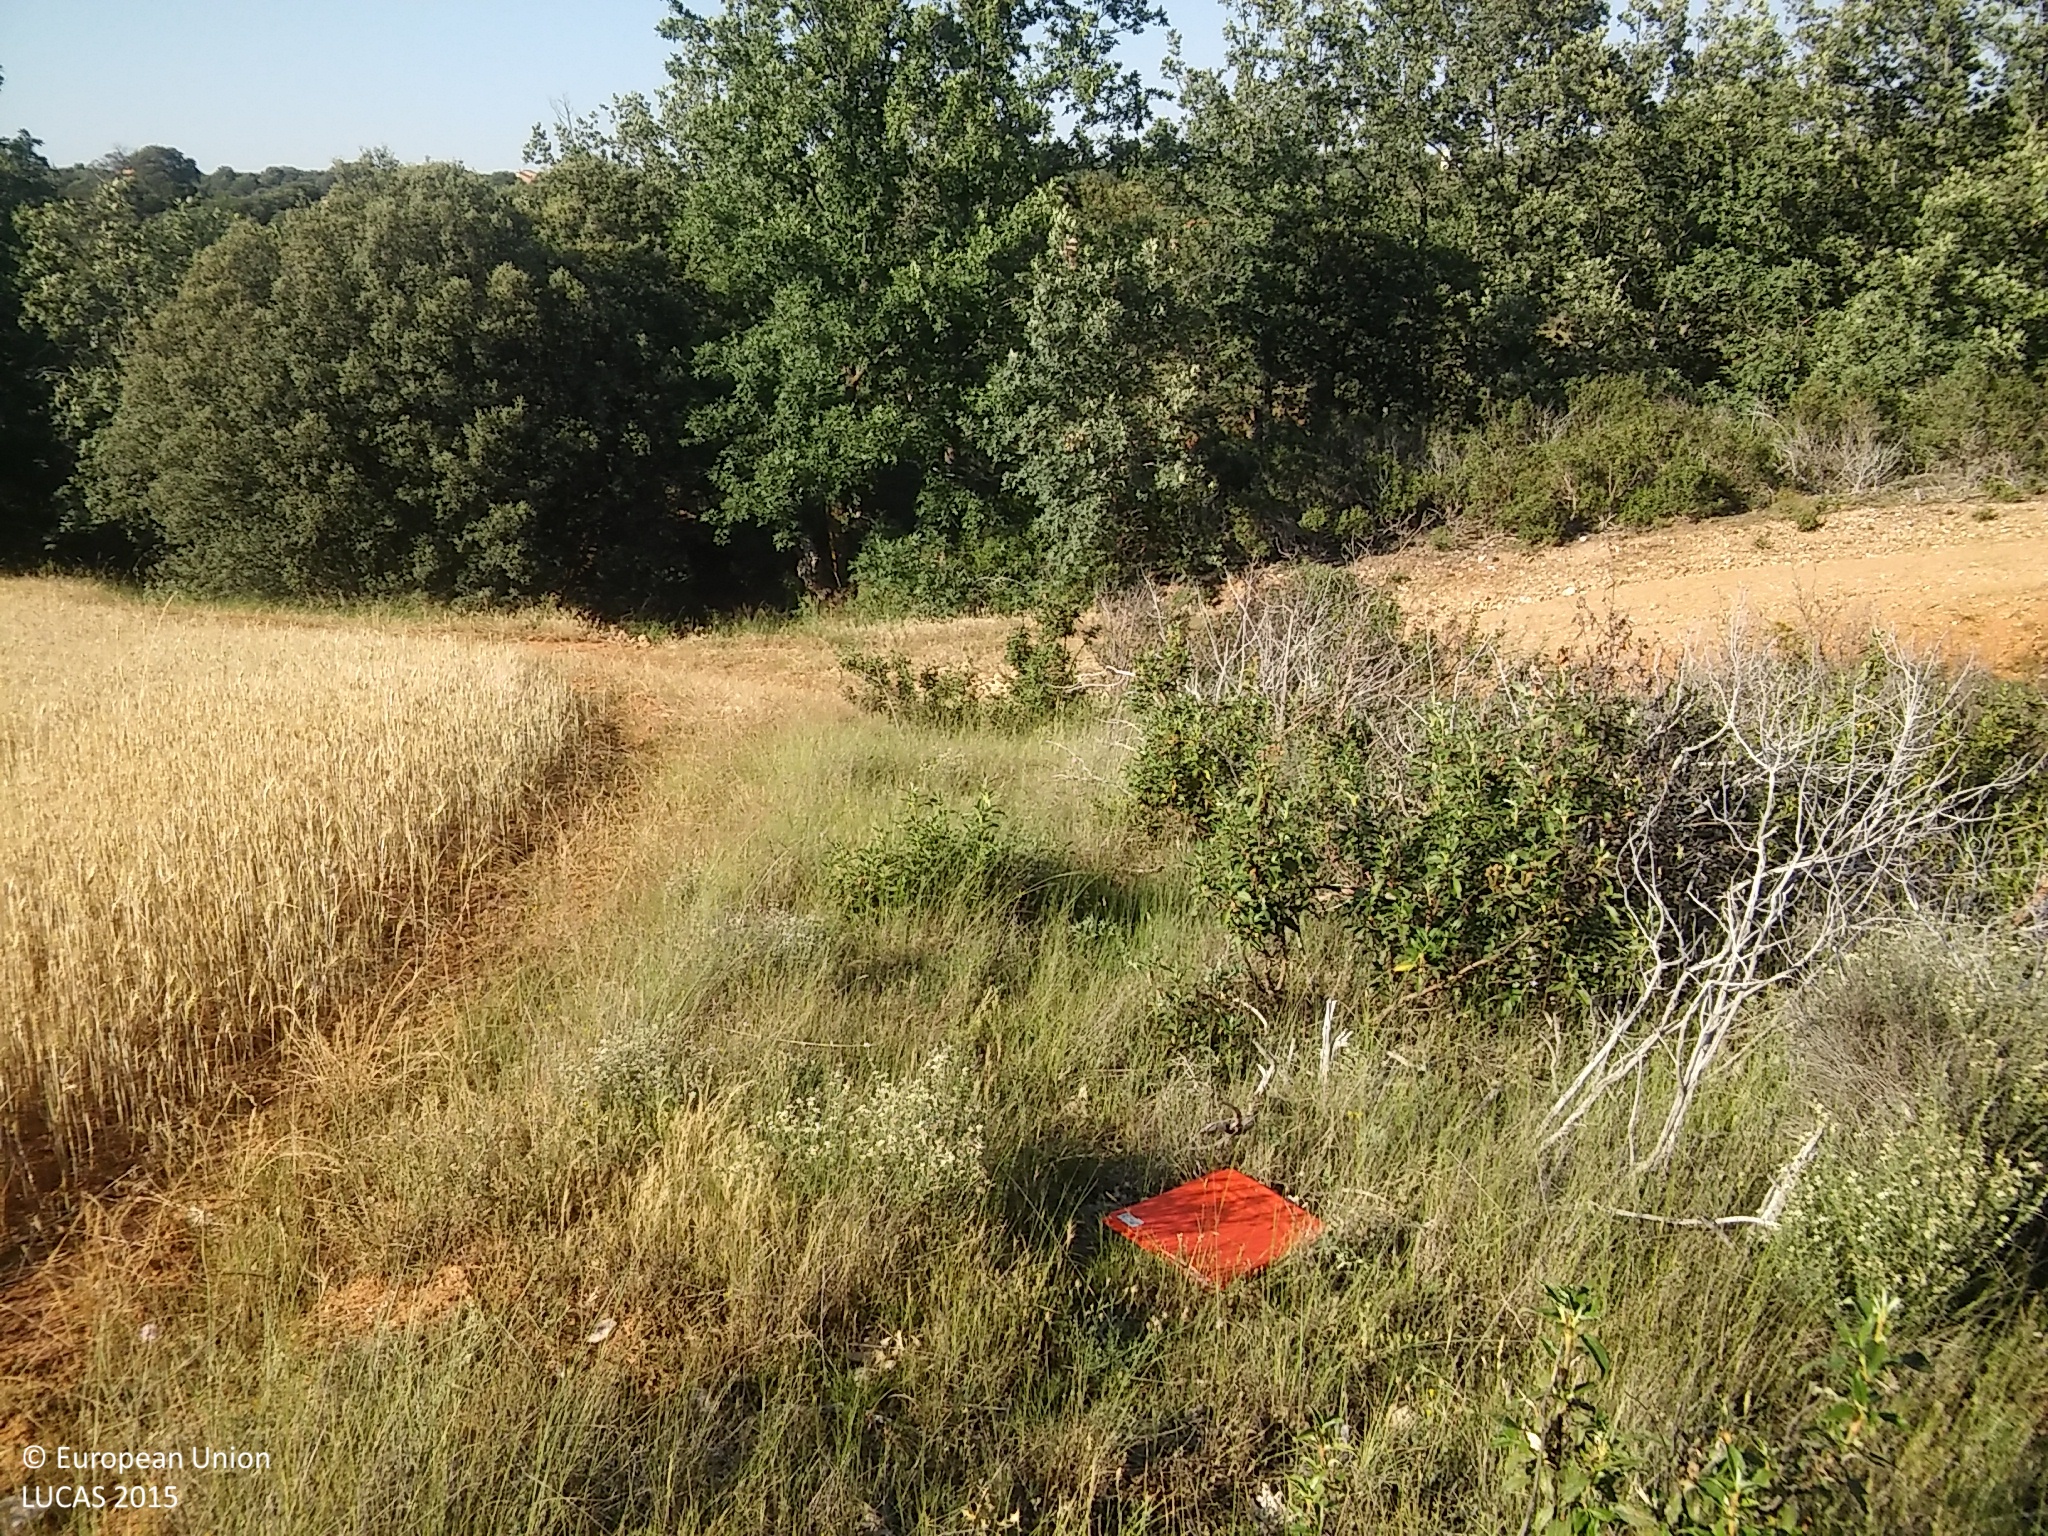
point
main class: Shrubland
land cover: Shrubland with sparse tree cover
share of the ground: 50 - 75 %
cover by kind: shrubs 65 %, herbaceous plants 30 %, broadleaved forest trees 5 %
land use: Semi-natural and natural areas not in use
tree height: > 5 m
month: June
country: ES
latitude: 41.3380
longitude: -3.5380
